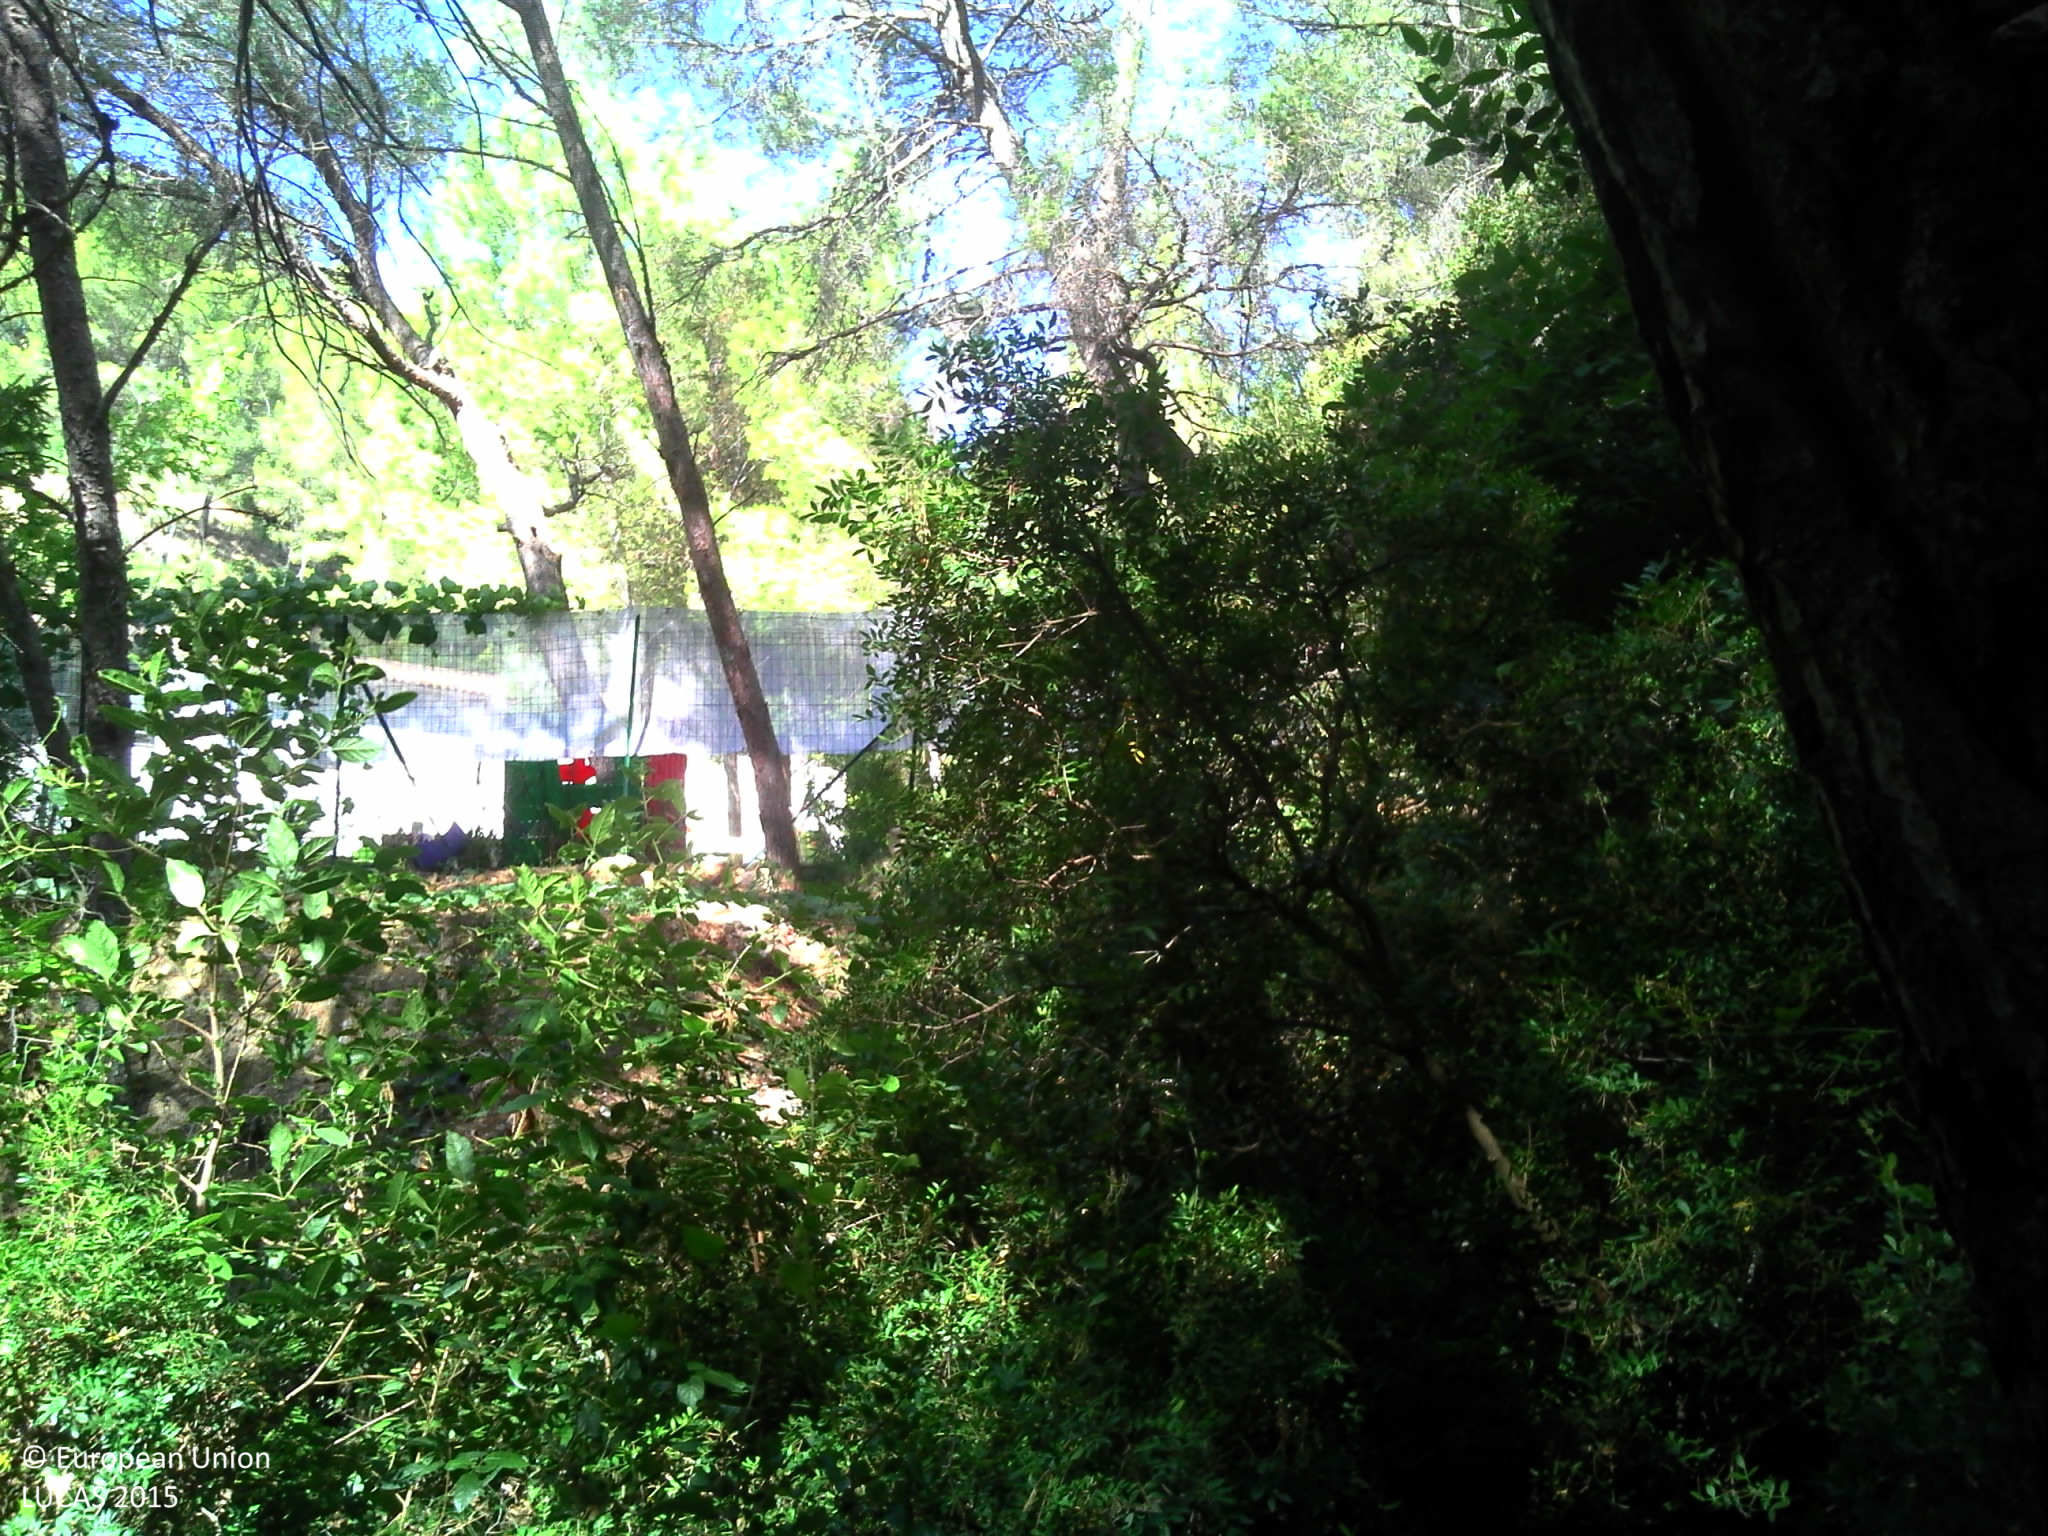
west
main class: Woodland
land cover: Pine dominated coniferous woodland
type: coniferous forest of the mediterranean region
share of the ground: > 75 %
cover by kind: coniferous forest trees 90 %, consolidated bare surface 10 %
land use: Residential
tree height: > 5 m
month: July
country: FR
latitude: 43.1611
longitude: 5.7427
